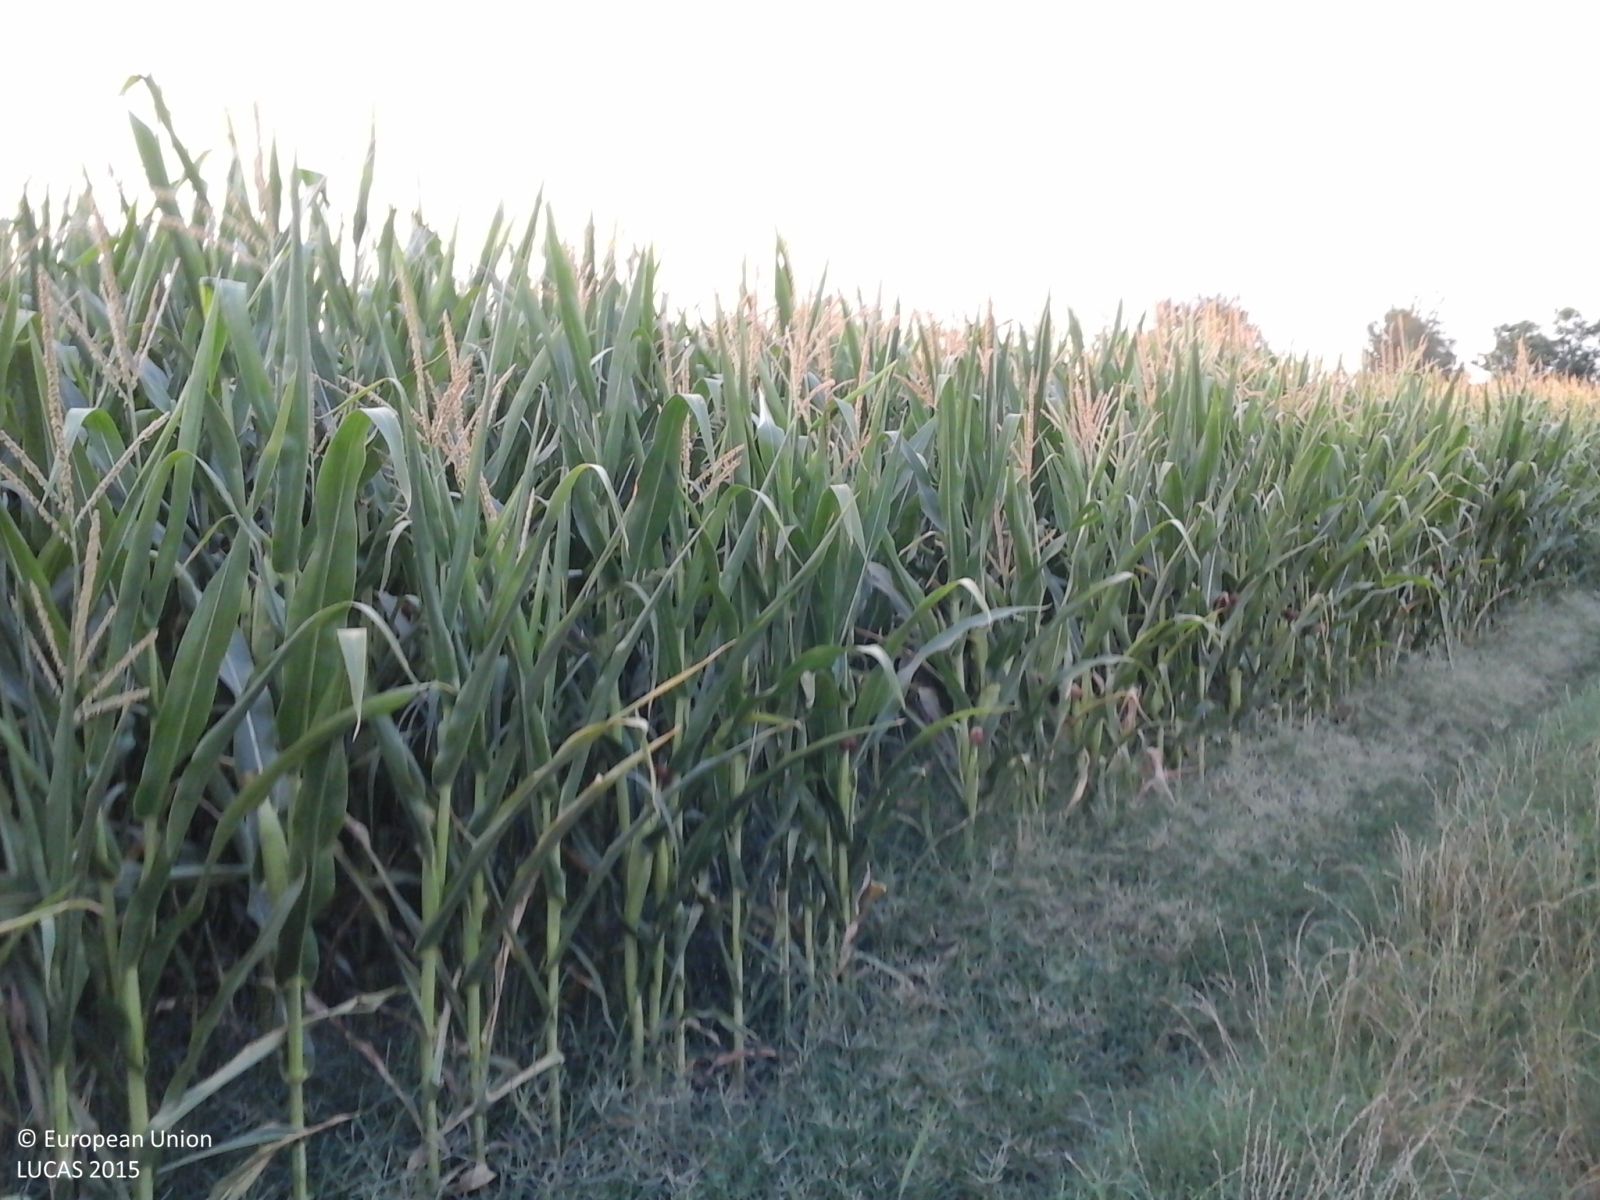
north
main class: Cropland
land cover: Maize
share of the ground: > 75 %
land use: Agriculture (excluding fallow land and kitchen gardens)
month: July
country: IT
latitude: 44.3514
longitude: 11.8902
